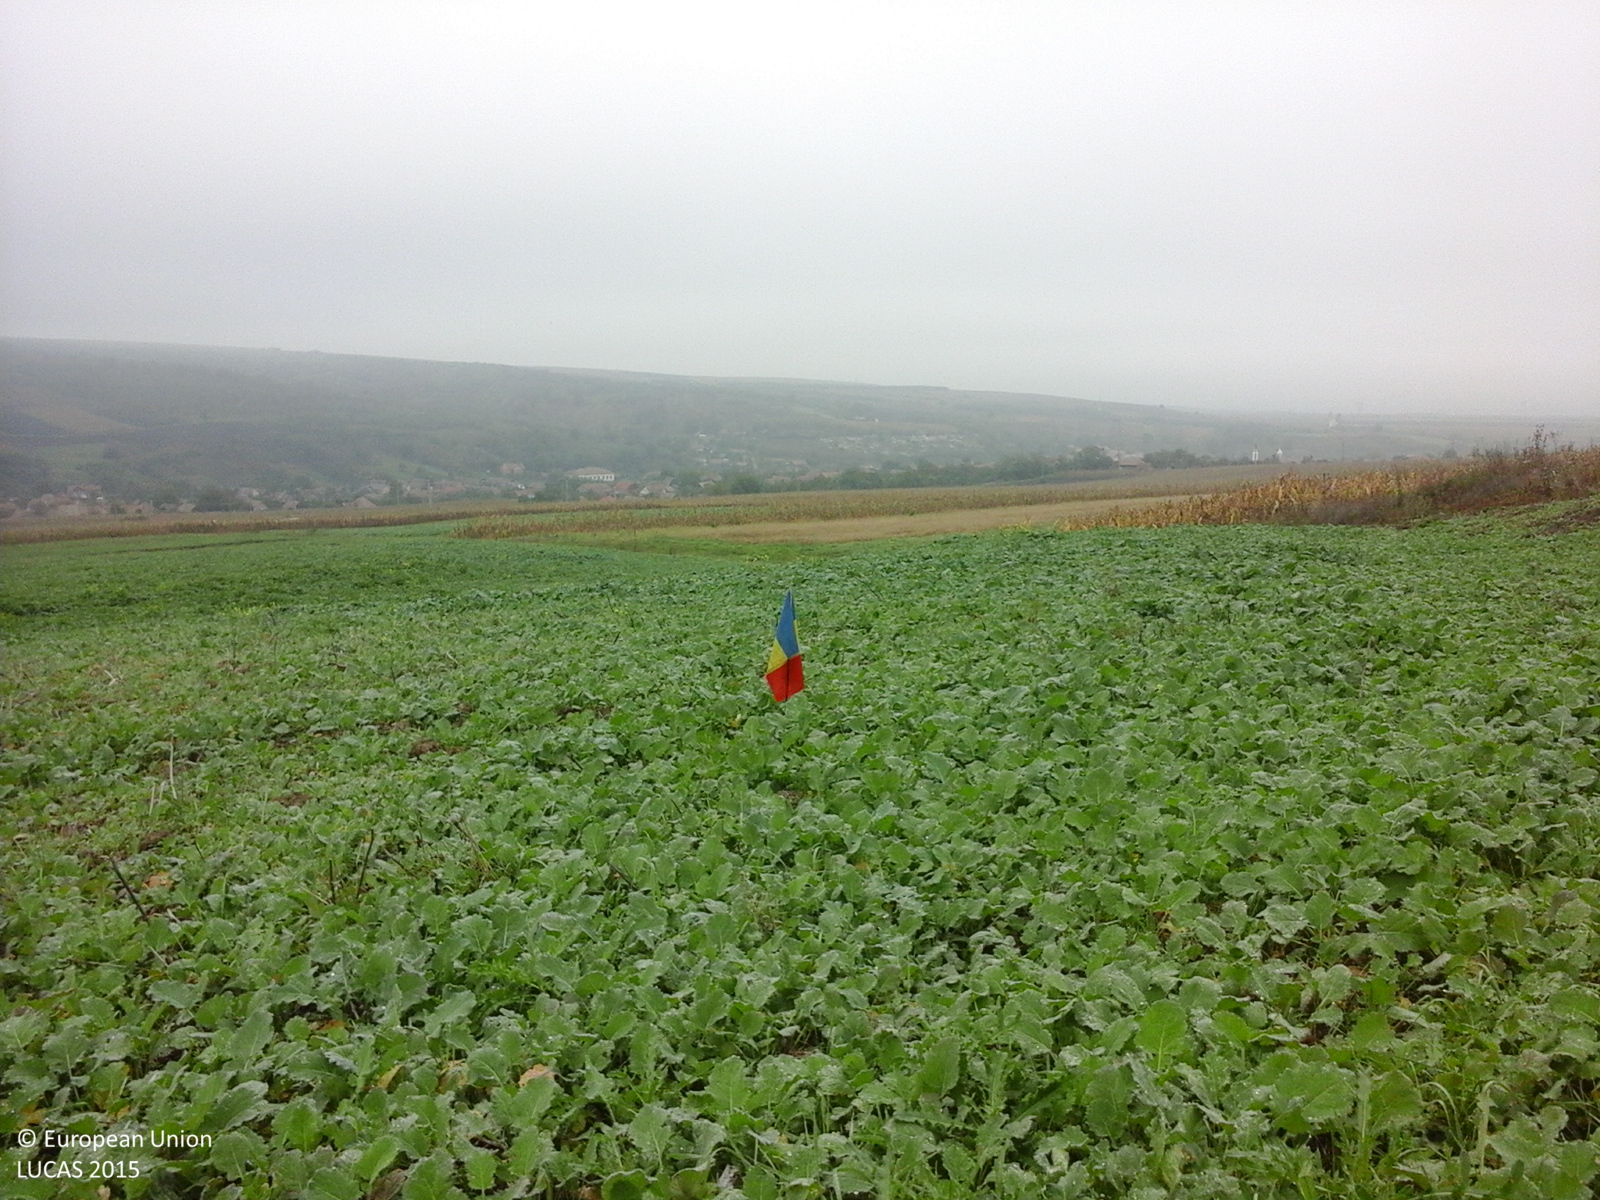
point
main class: Cropland
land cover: Rape and turnip rape
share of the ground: > 75 %
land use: Agriculture (excluding fallow land and kitchen gardens)
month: October
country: RO
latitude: 46.3938
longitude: 24.2698
